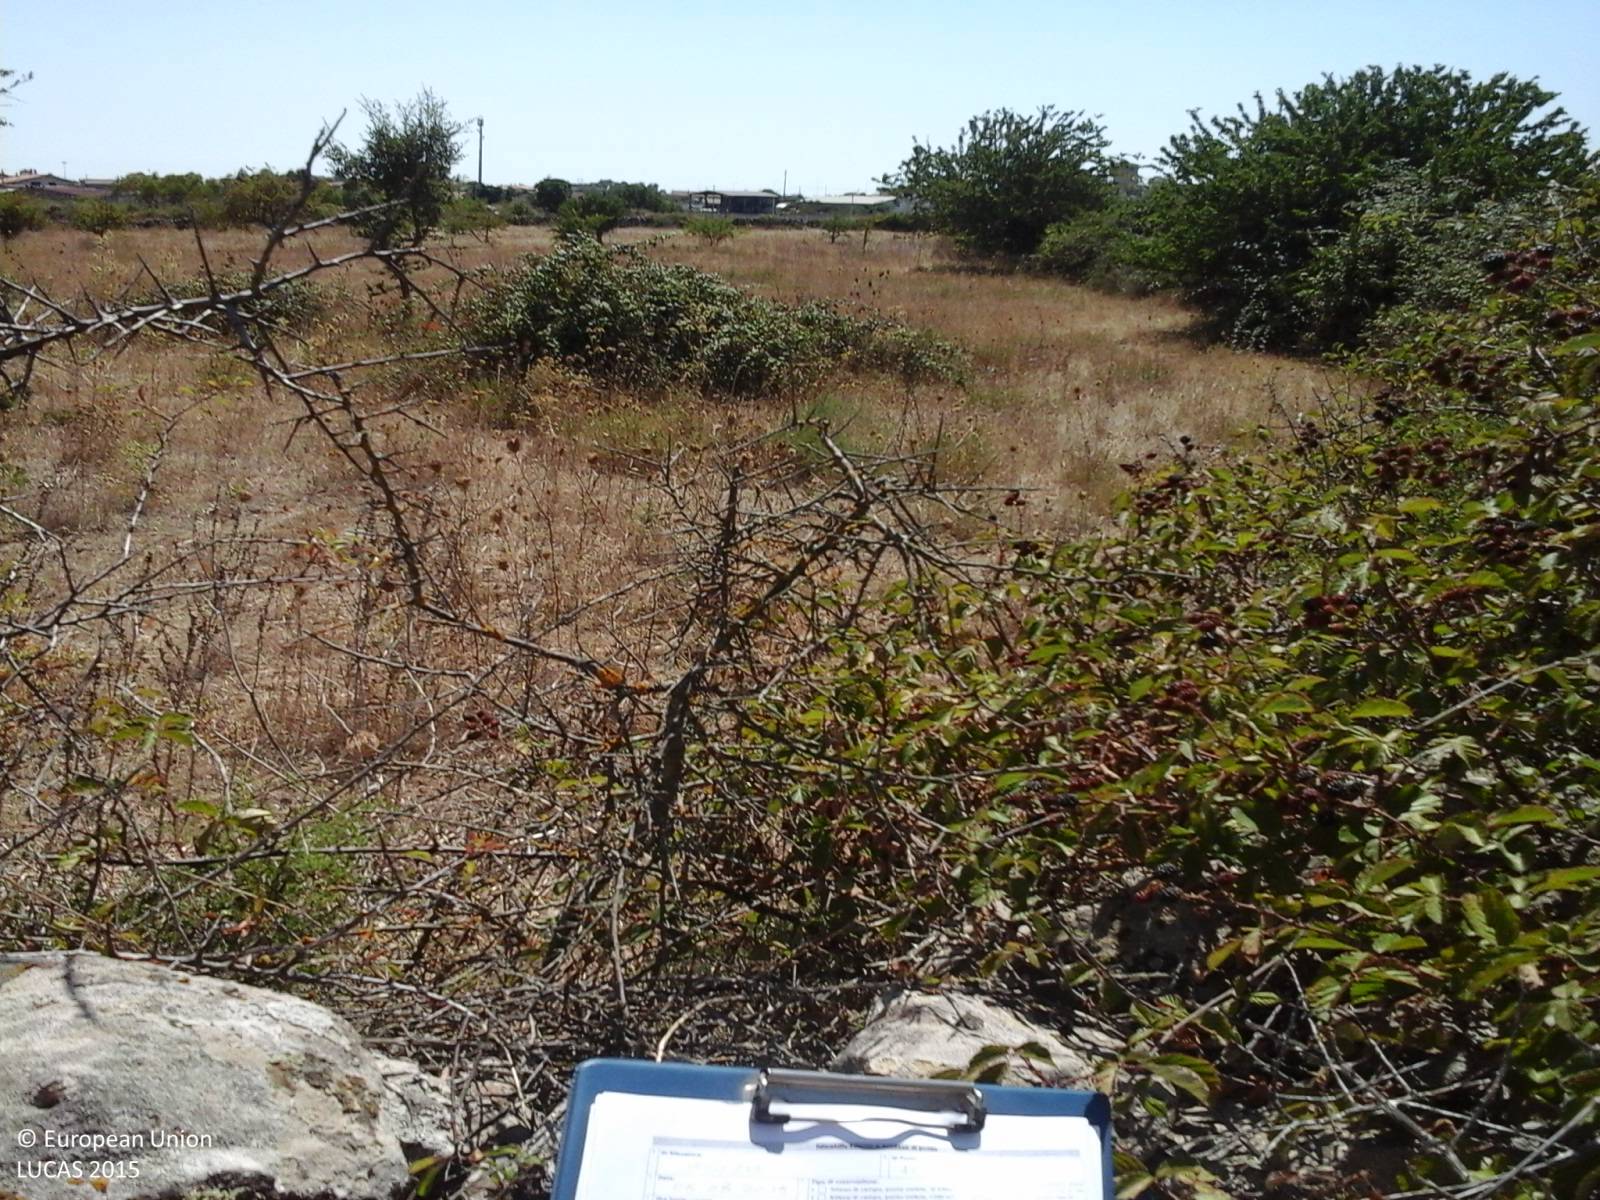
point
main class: Grassland
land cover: Grassland without tree/shrub cover
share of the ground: > 75 %
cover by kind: herbaceous plants 100 %
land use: Agriculture (excluding fallow land and kitchen gardens)
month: August
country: IT
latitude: 40.1335
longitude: 8.8210
